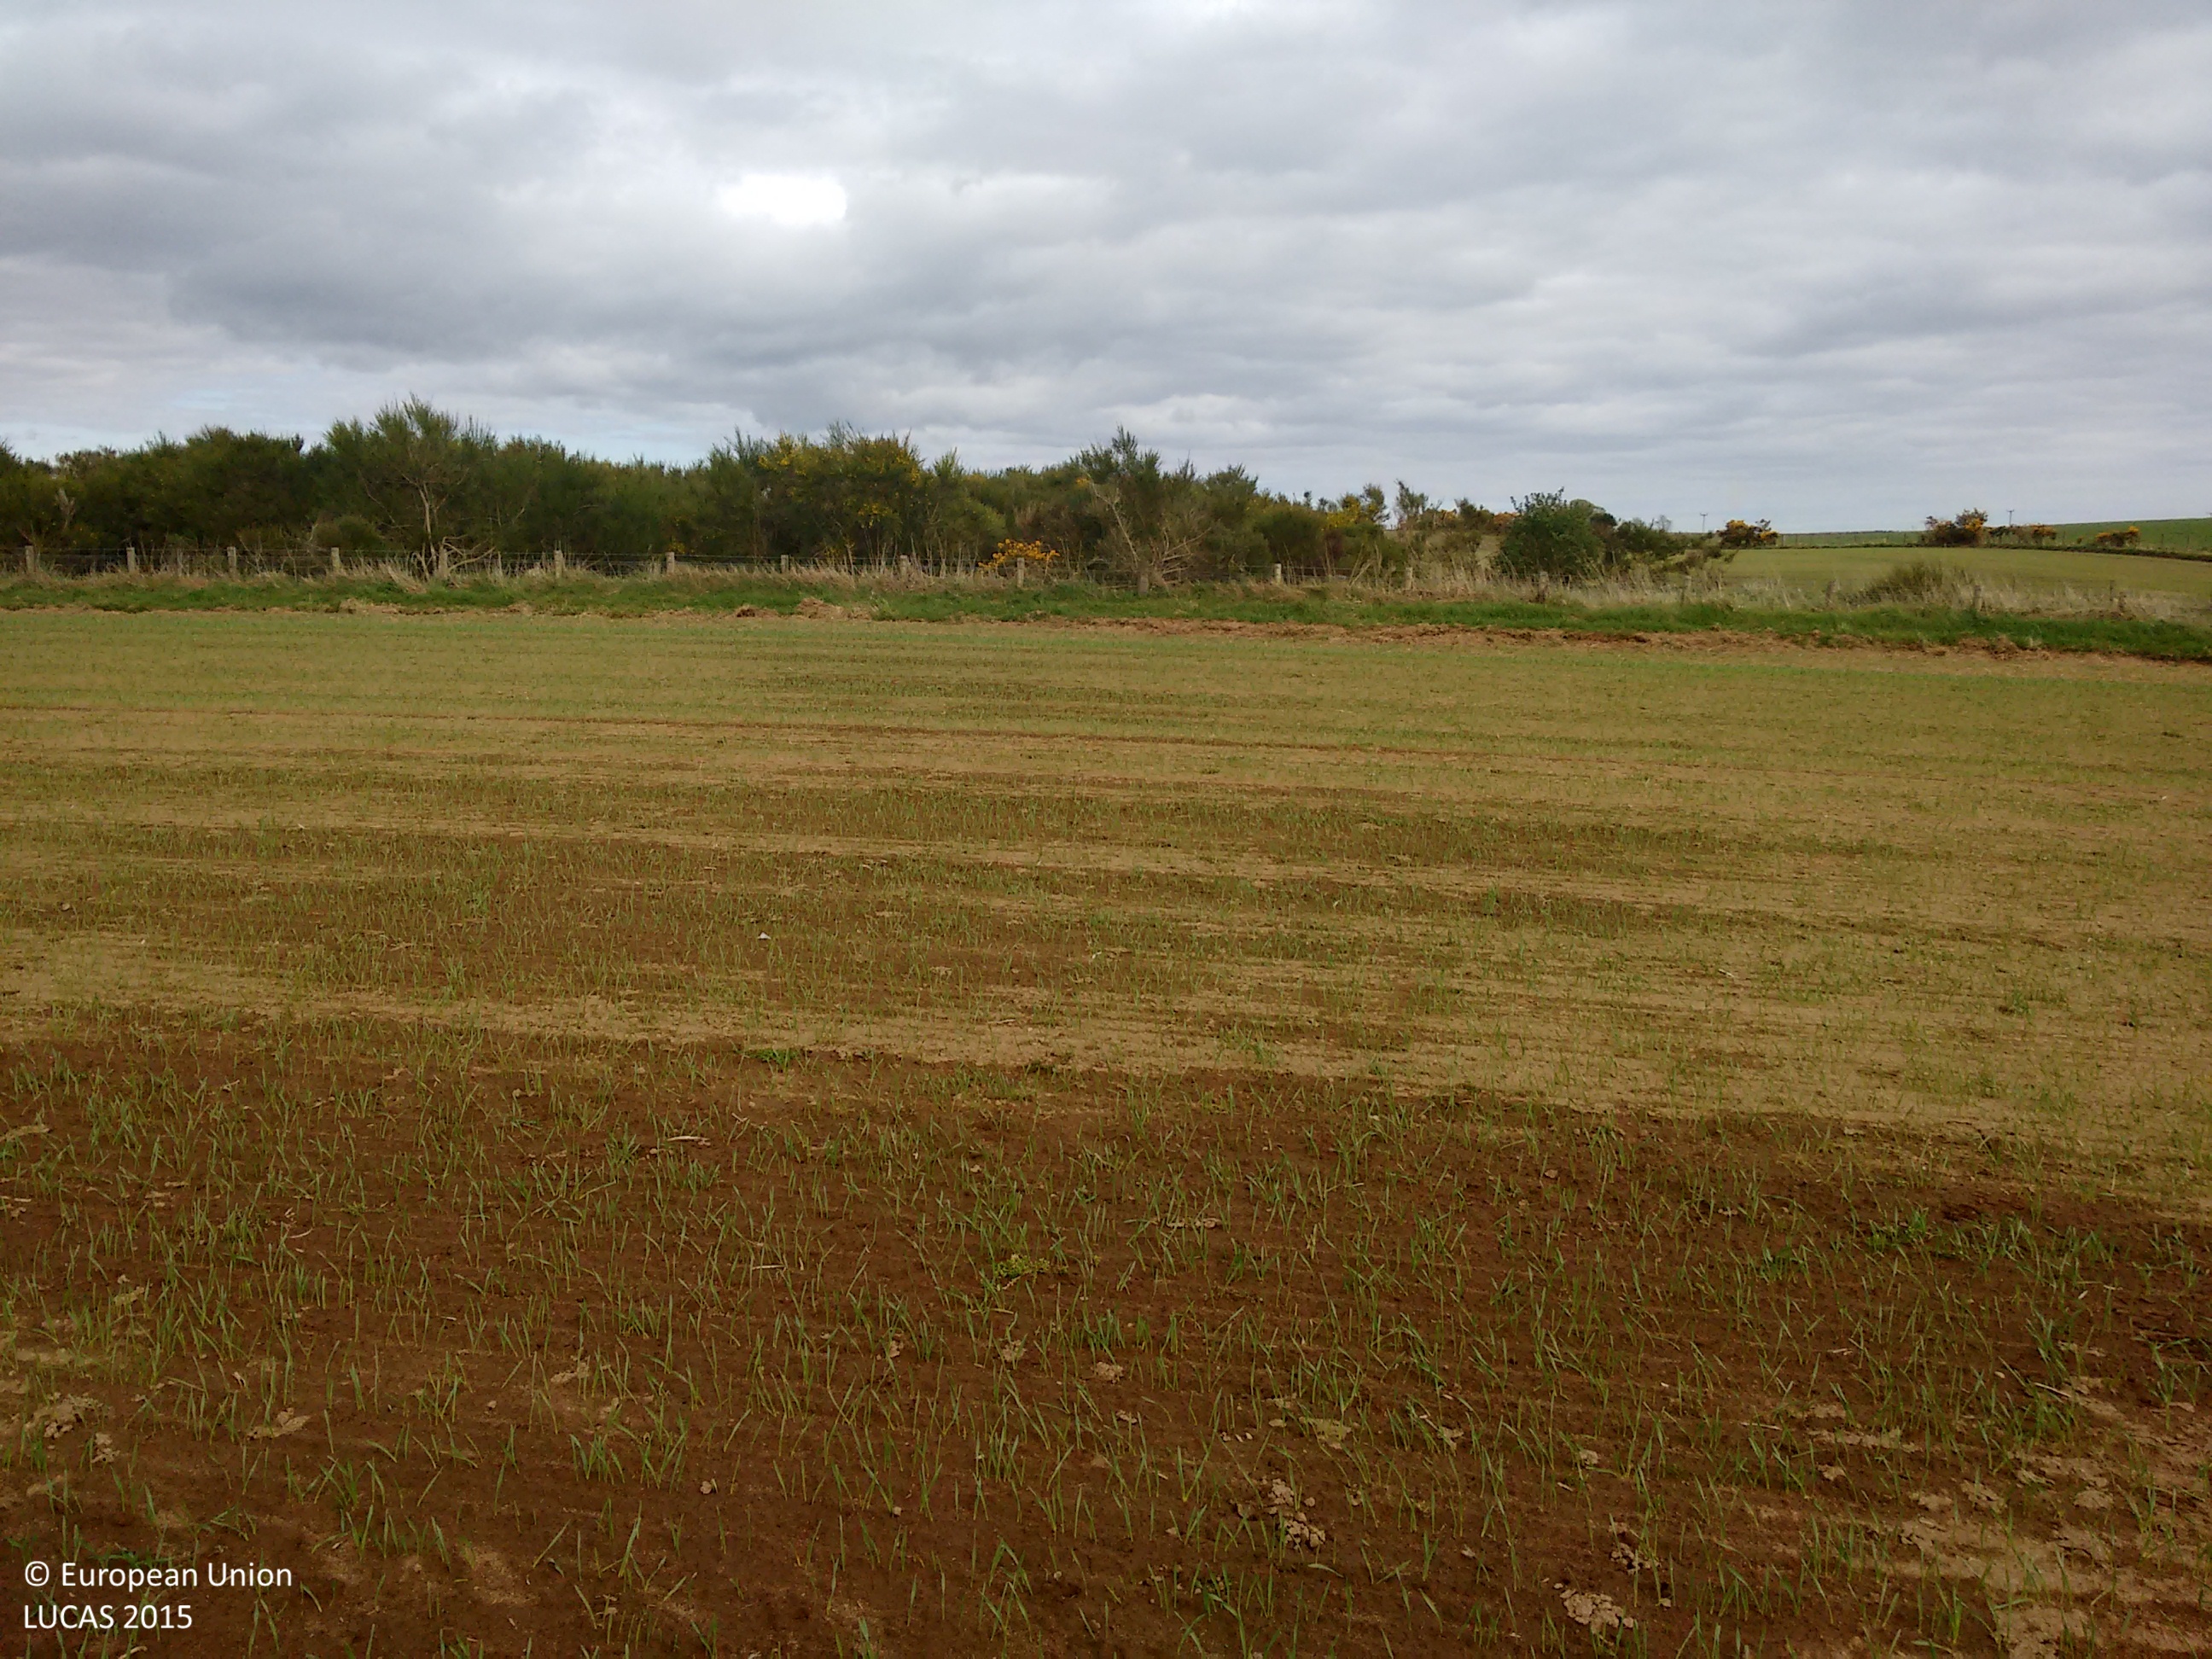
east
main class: Cropland
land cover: Common wheat
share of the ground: 25 - 50 %
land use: Agriculture (excluding fallow land and kitchen gardens)
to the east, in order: Common wheat; Grass margins; Fences; Shrubland without tree cover; Common wheat
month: May
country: GB
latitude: 56.7003
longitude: -2.7170
